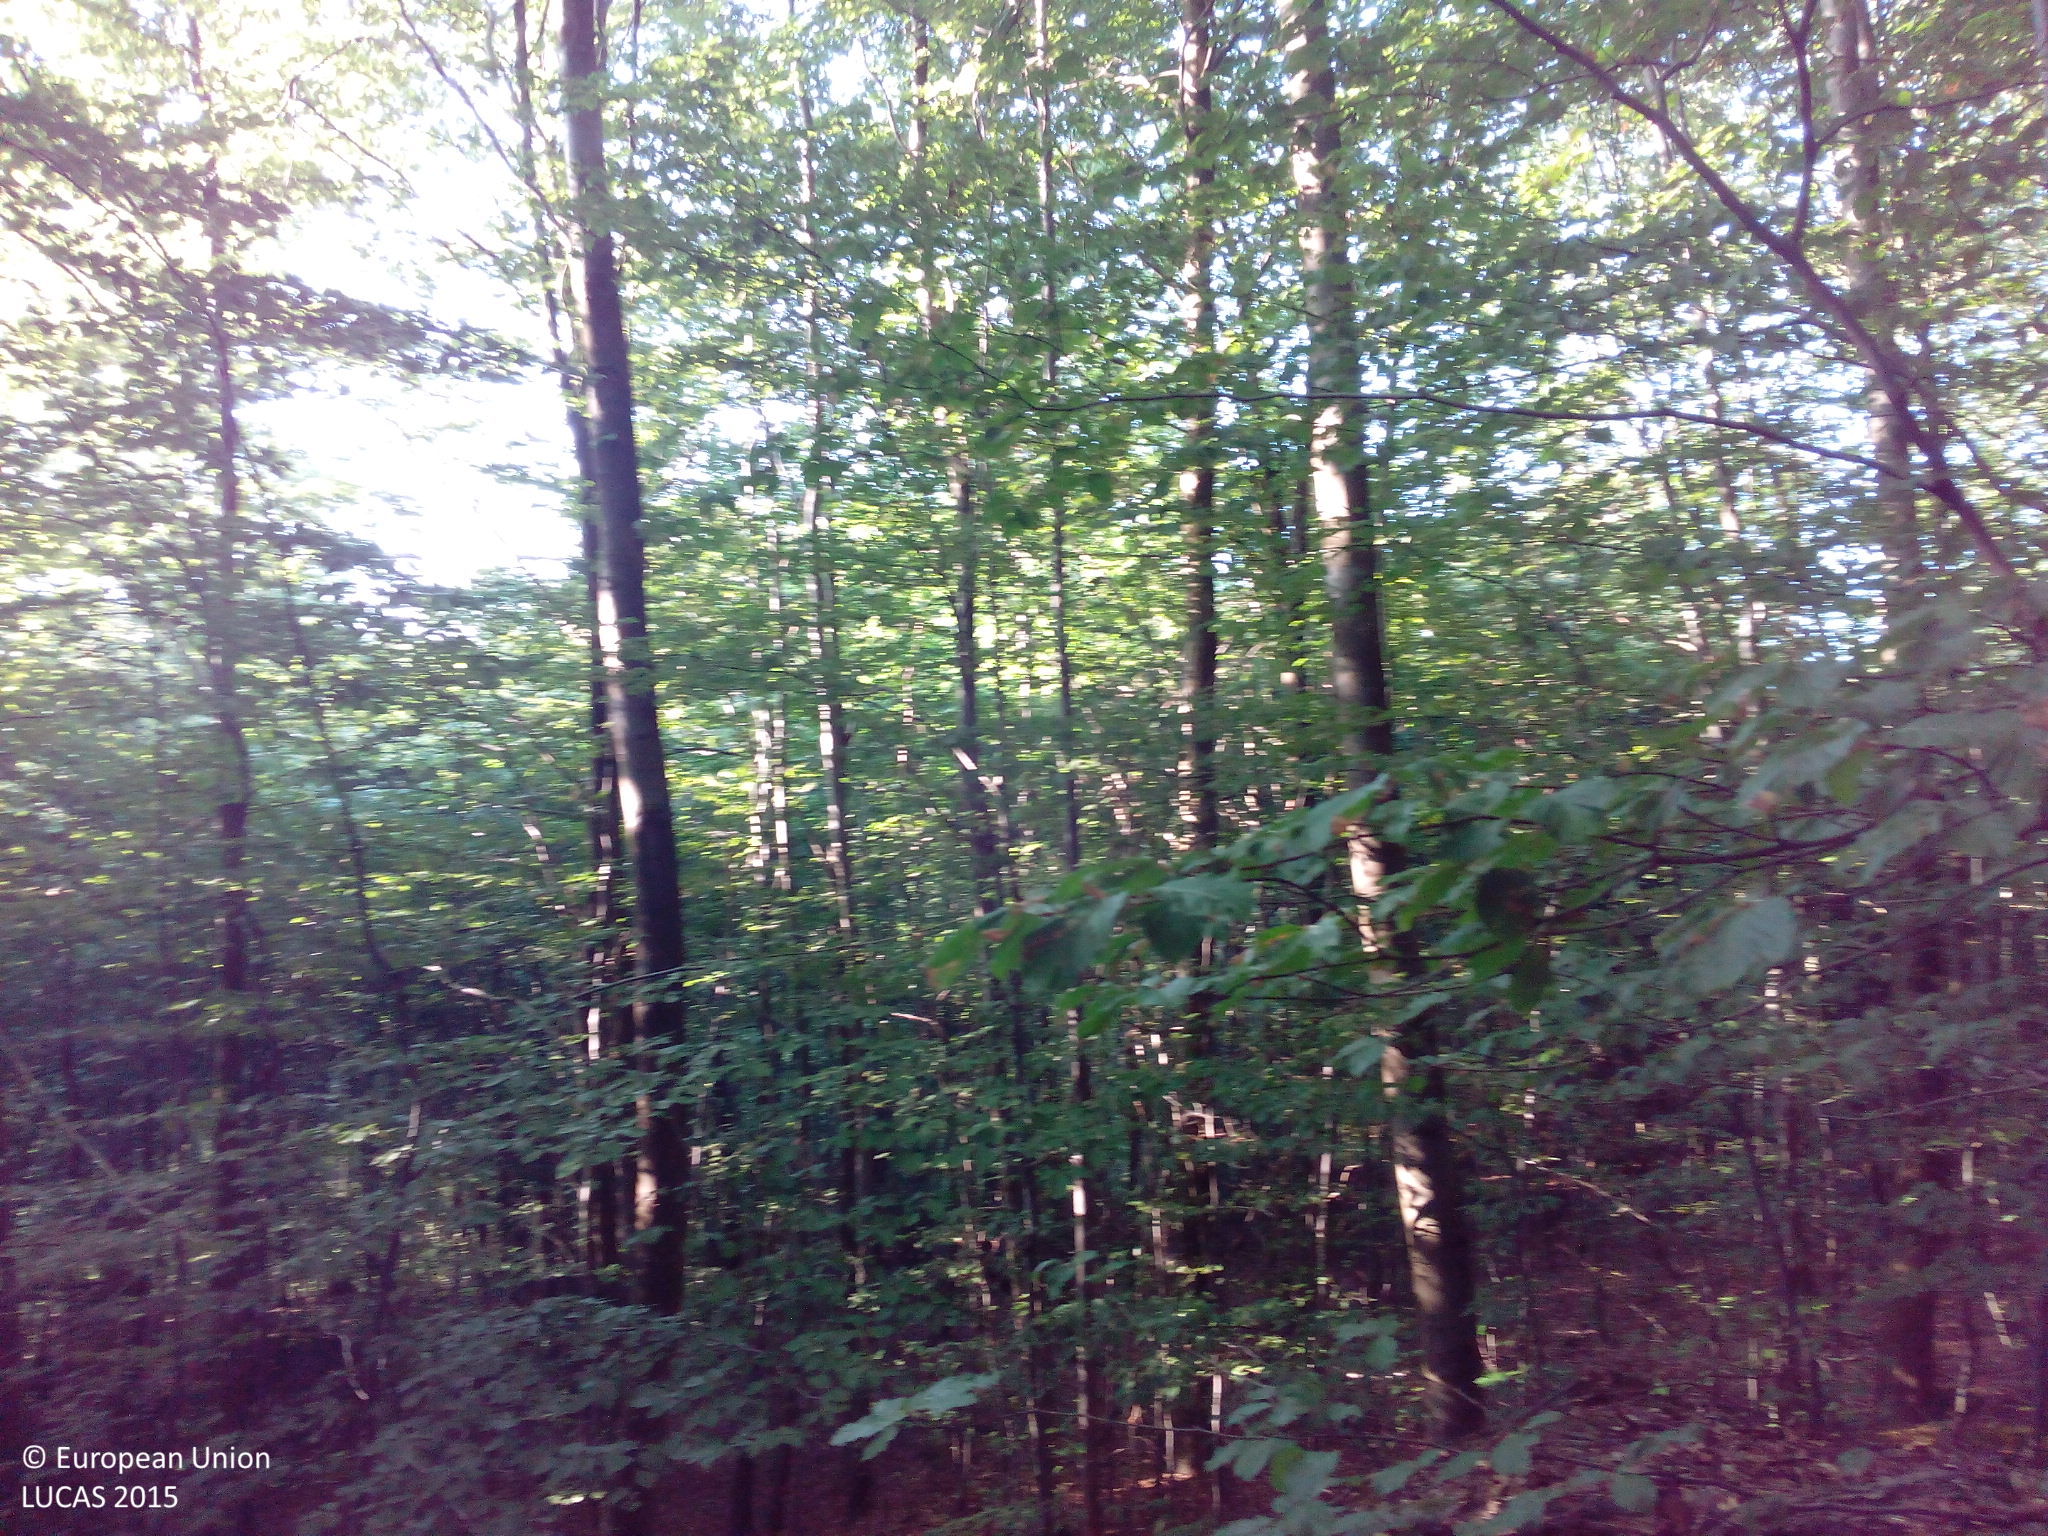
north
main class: Woodland
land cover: Broadleaved woodland
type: beech forest
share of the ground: > 75 %
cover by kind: broadleaved forest trees 90 %, unconsolidated bare surface 10 %
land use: Forestry
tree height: > 5 m
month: July
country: DE
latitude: 49.1514
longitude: 7.6012
